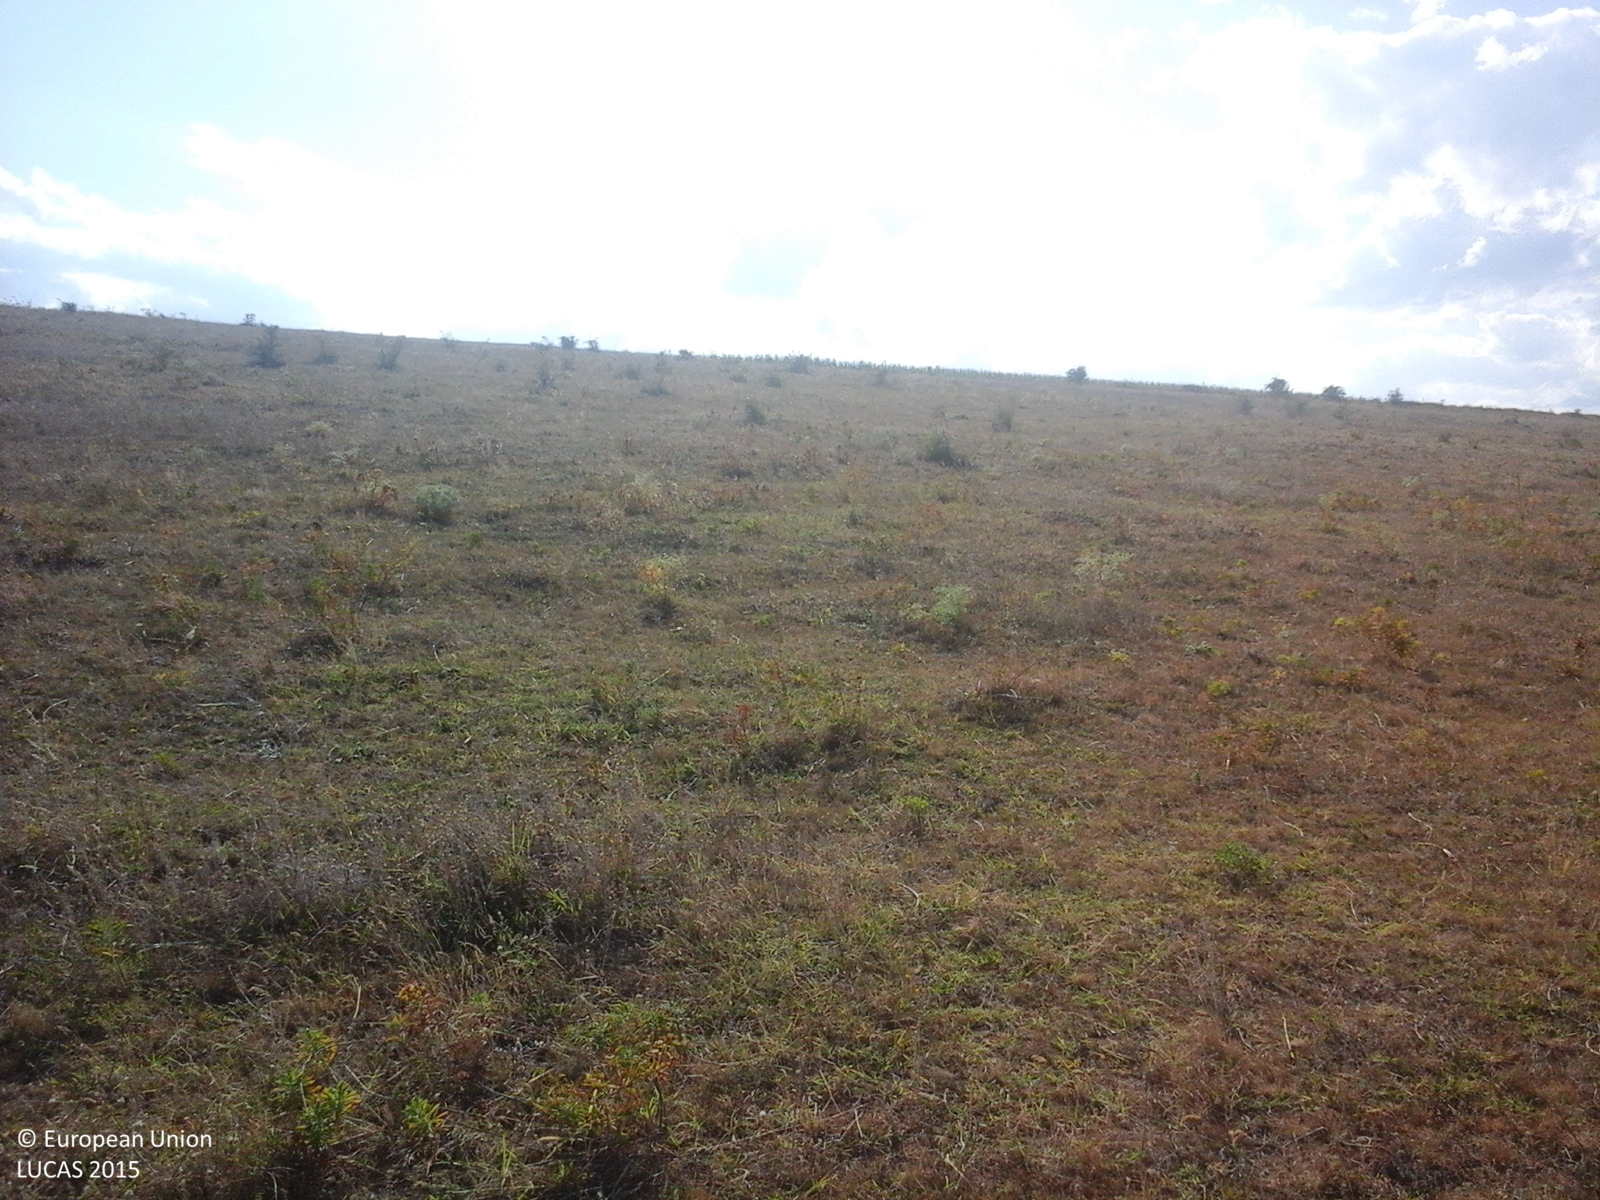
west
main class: Grassland
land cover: Spontaneously vegetated surfaces
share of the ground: > 75 %
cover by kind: herbaceous plants 100 %
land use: Fallow land
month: August
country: RO
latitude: 46.2789
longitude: 27.9144
